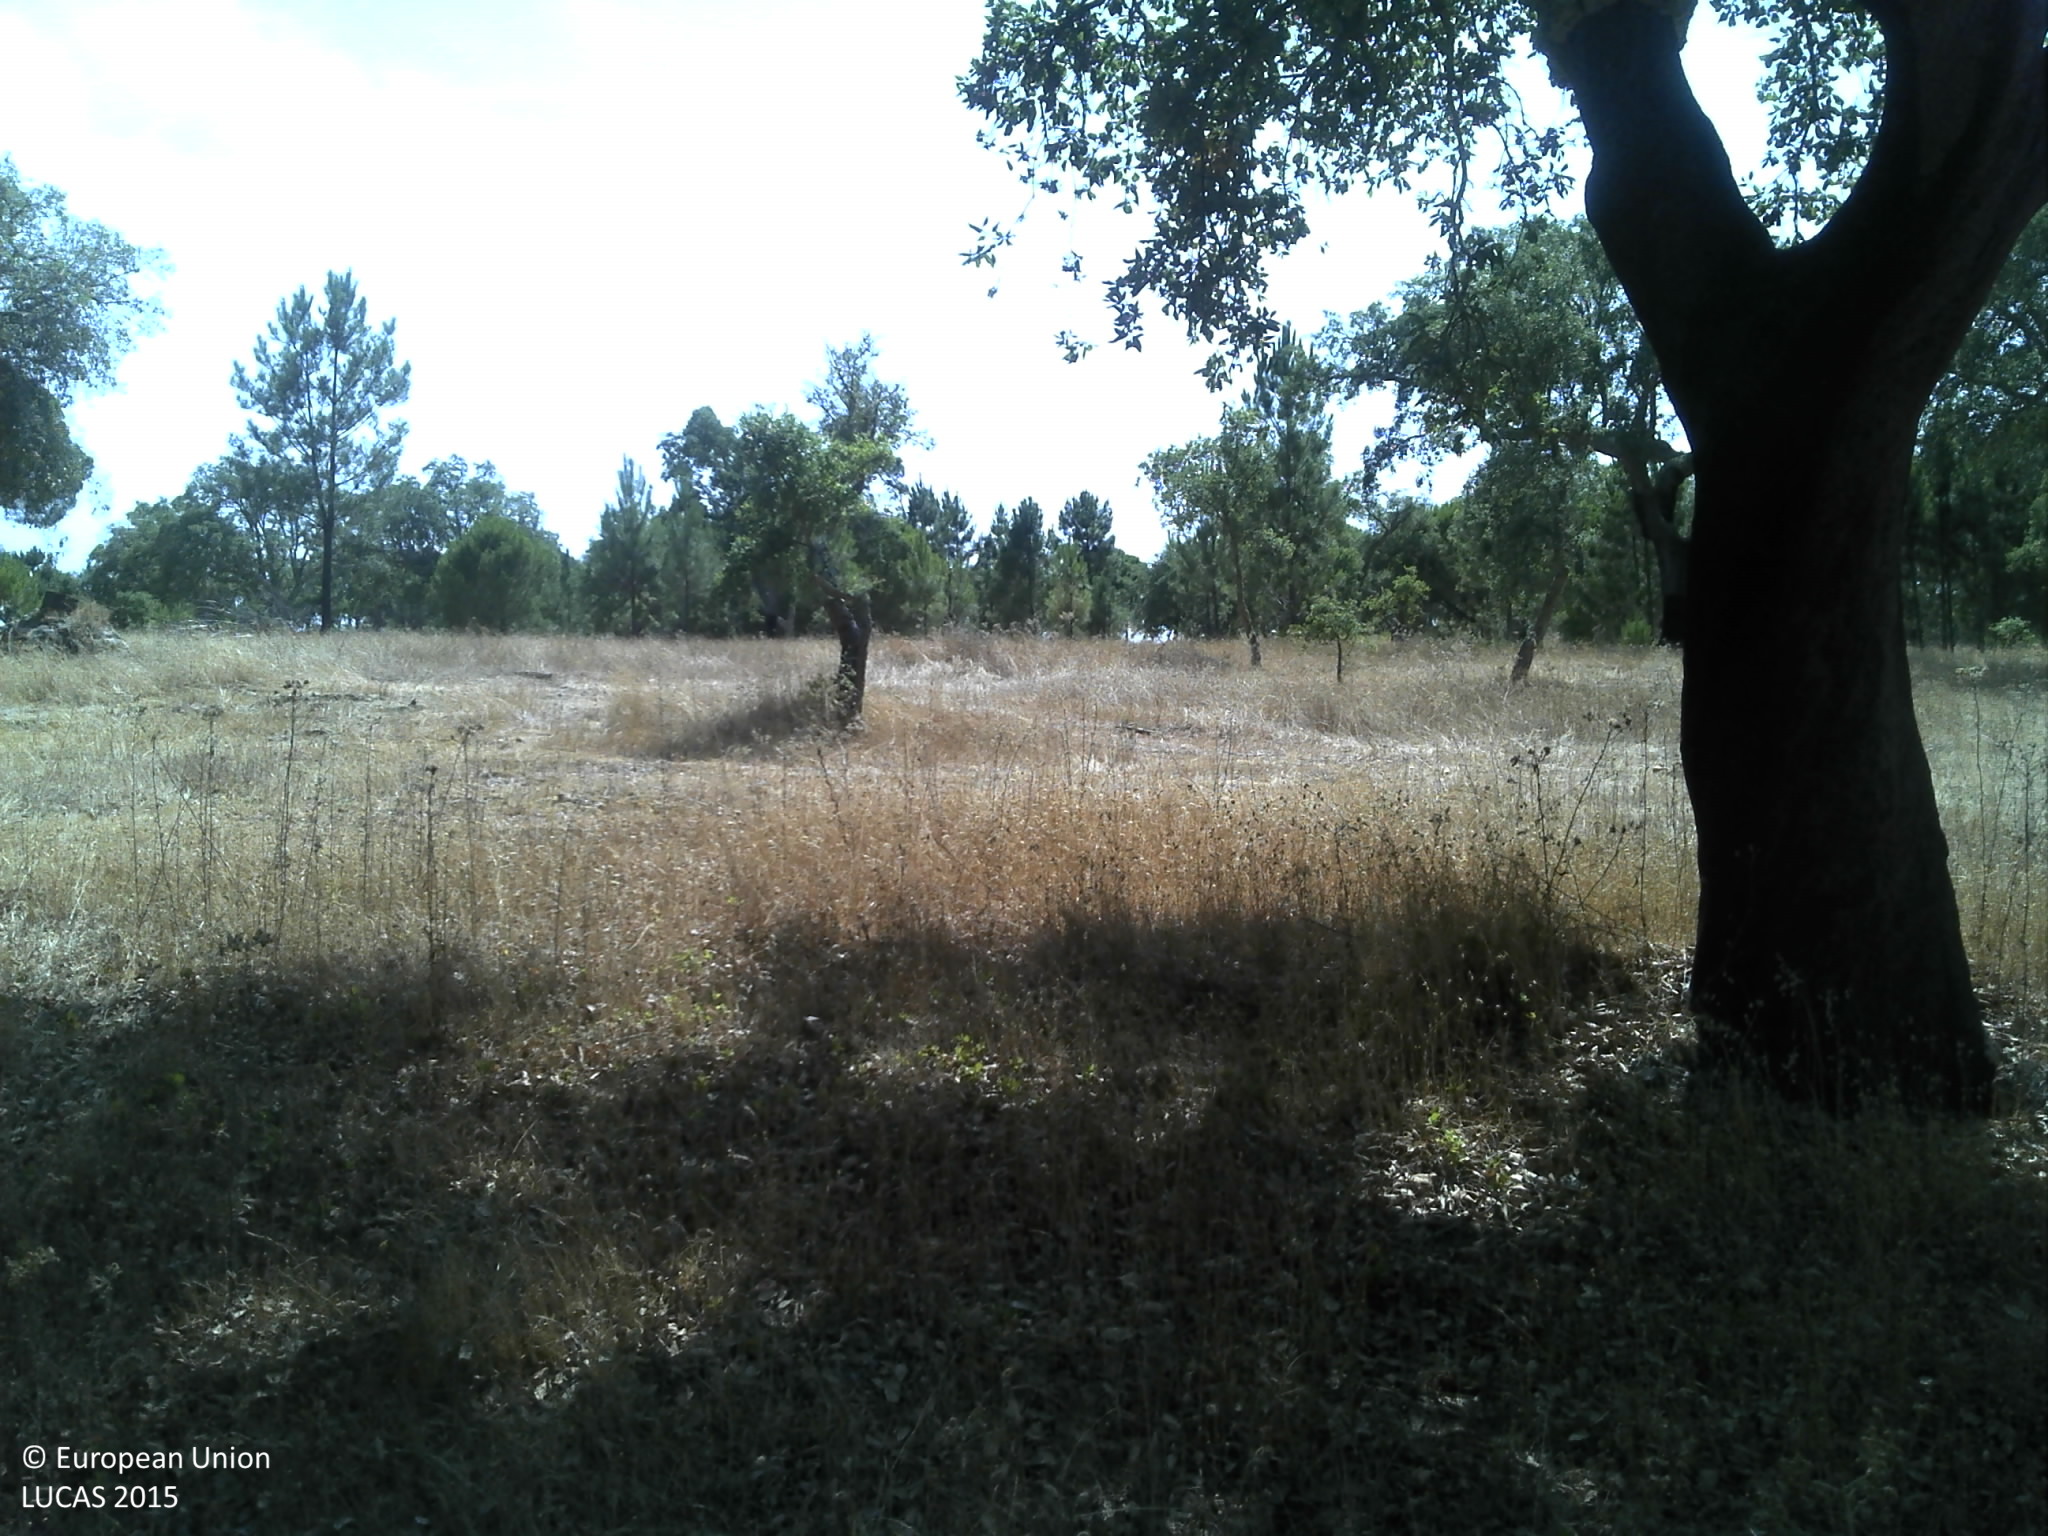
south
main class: Woodland
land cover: Pine dominated coniferous woodland
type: coniferous forest of the mediterranean region
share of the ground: 25 - 50 %
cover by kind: coniferous forest trees 40 %, herbaceous plants 30 %, unconsolidated bare surface 30 %
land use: Forestry
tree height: > 5 m
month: July
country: PT
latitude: 39.1167
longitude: -8.2277
